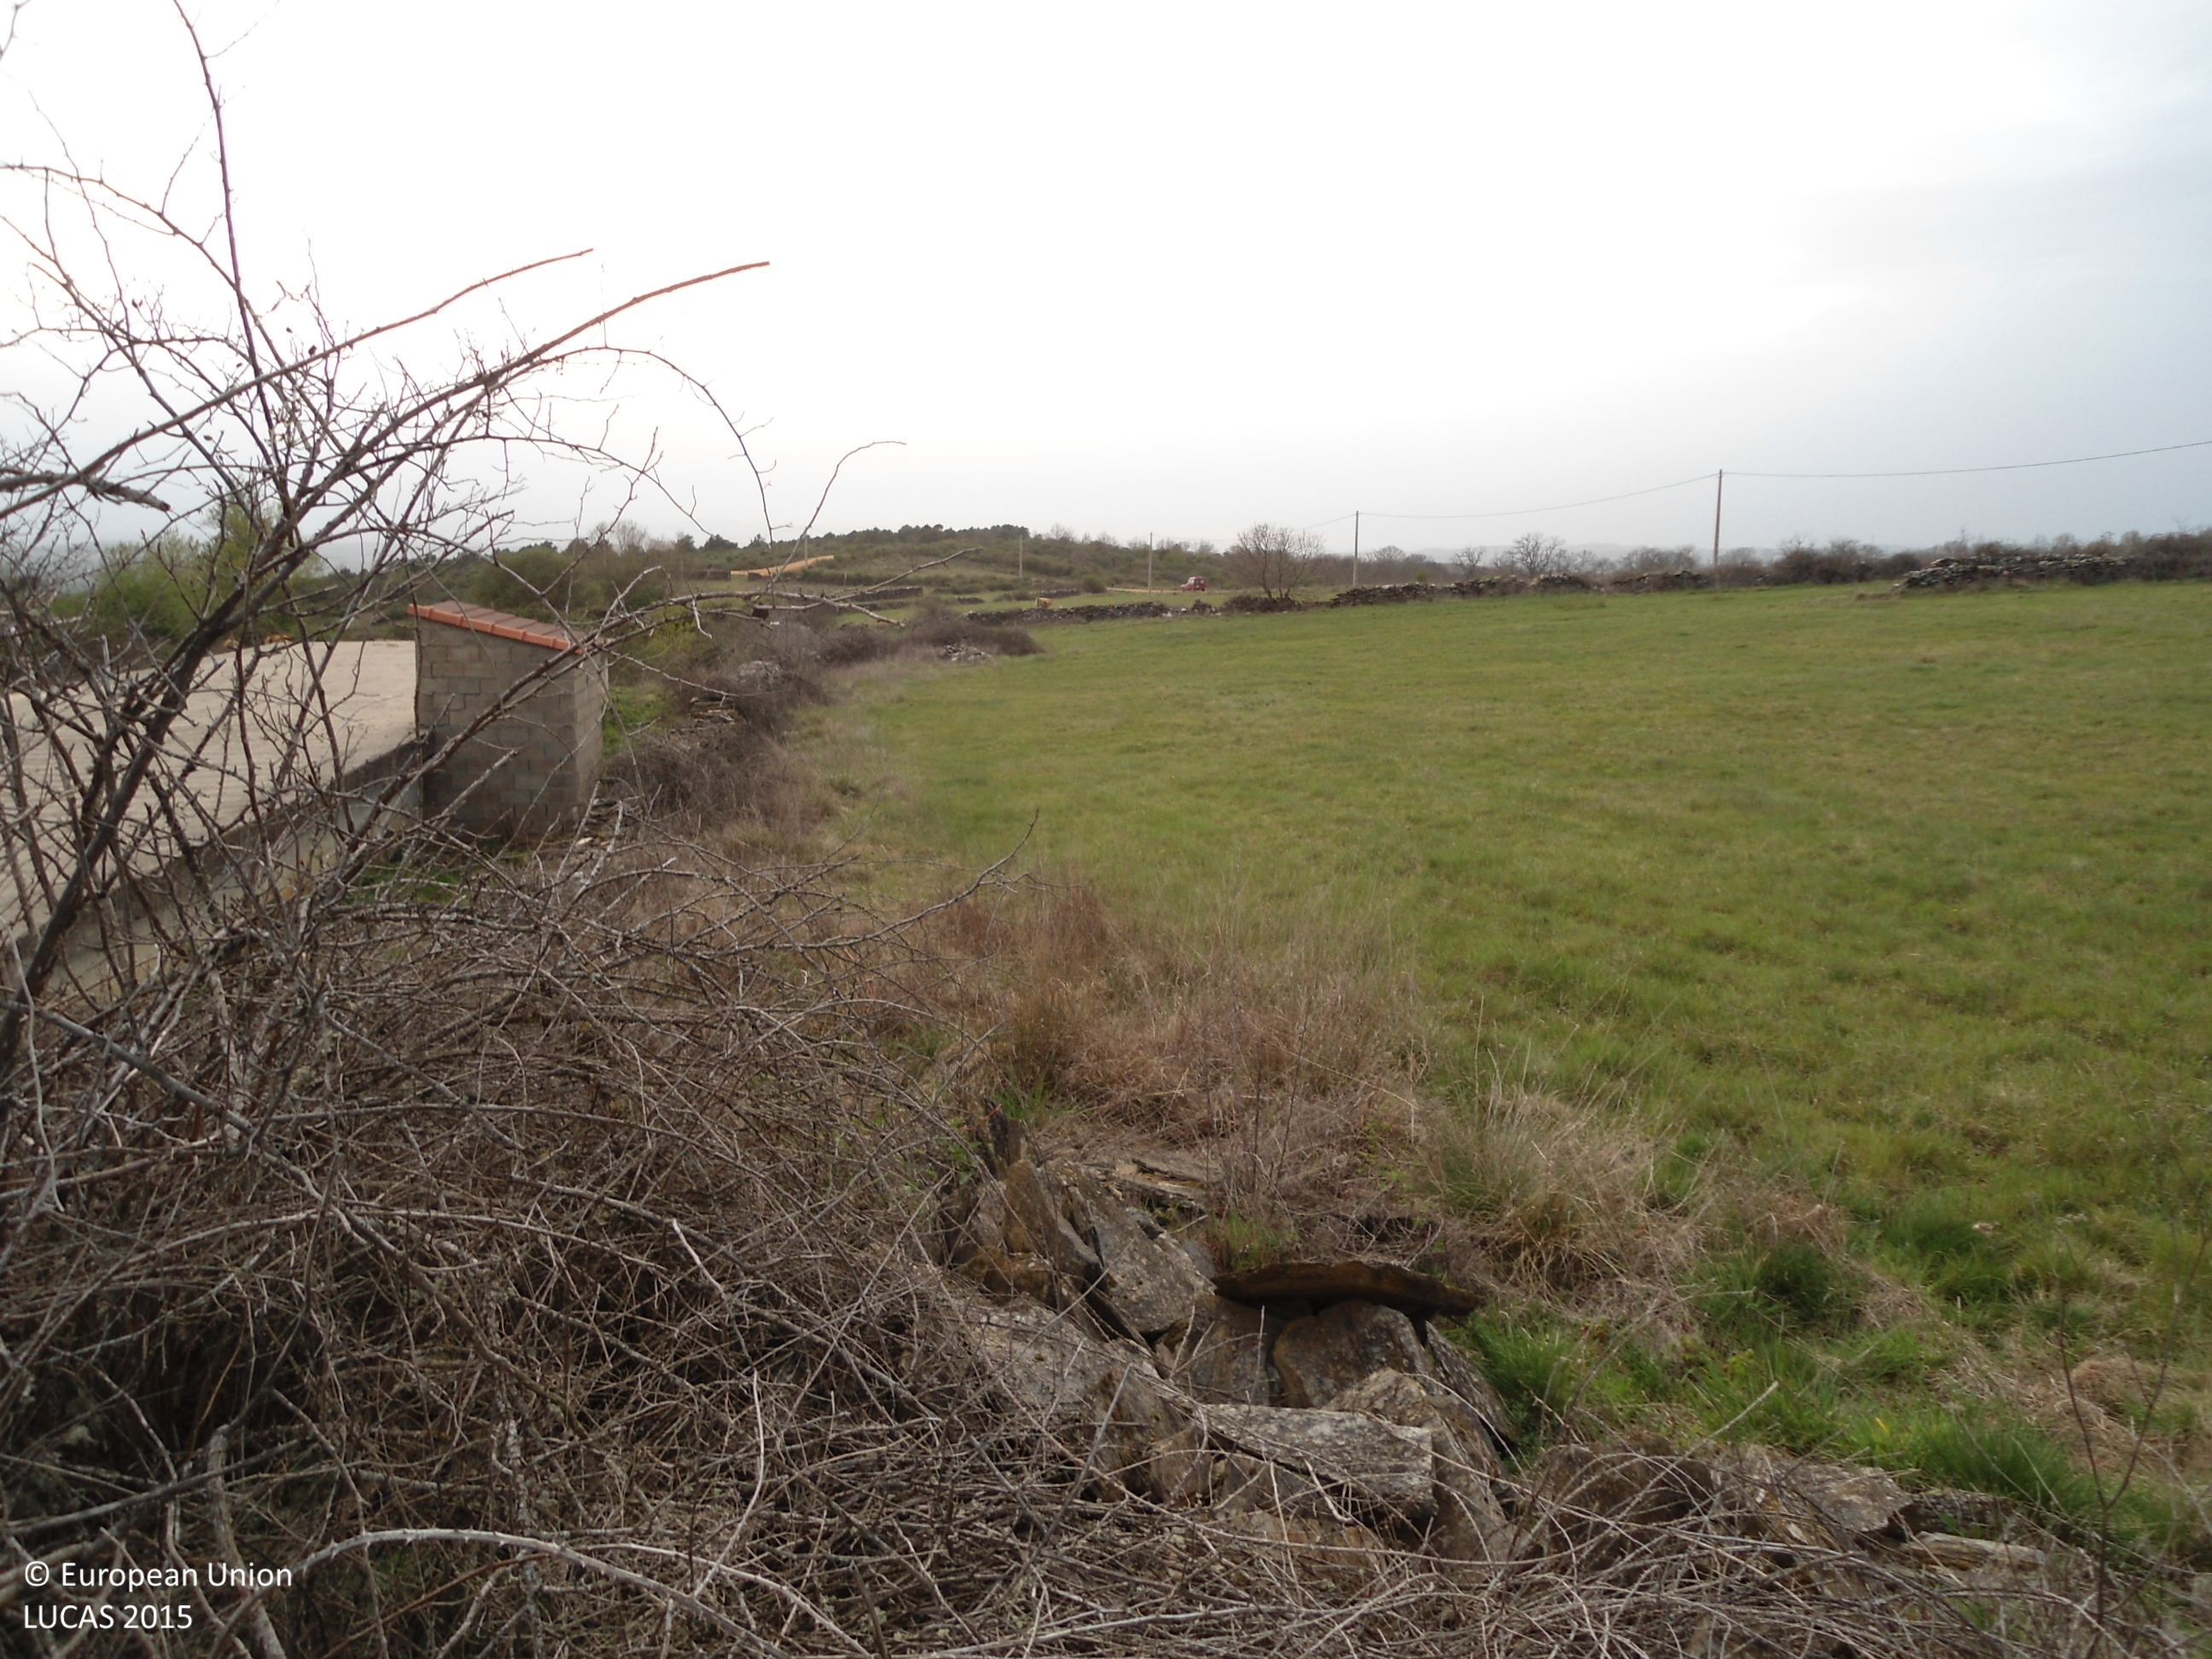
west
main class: Grassland
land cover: Grassland without tree/shrub cover
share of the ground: > 75 %
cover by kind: herbaceous plants 100 %
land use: Agriculture (excluding fallow land and kitchen gardens)
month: April
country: ES
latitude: 41.7541
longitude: -6.4740
